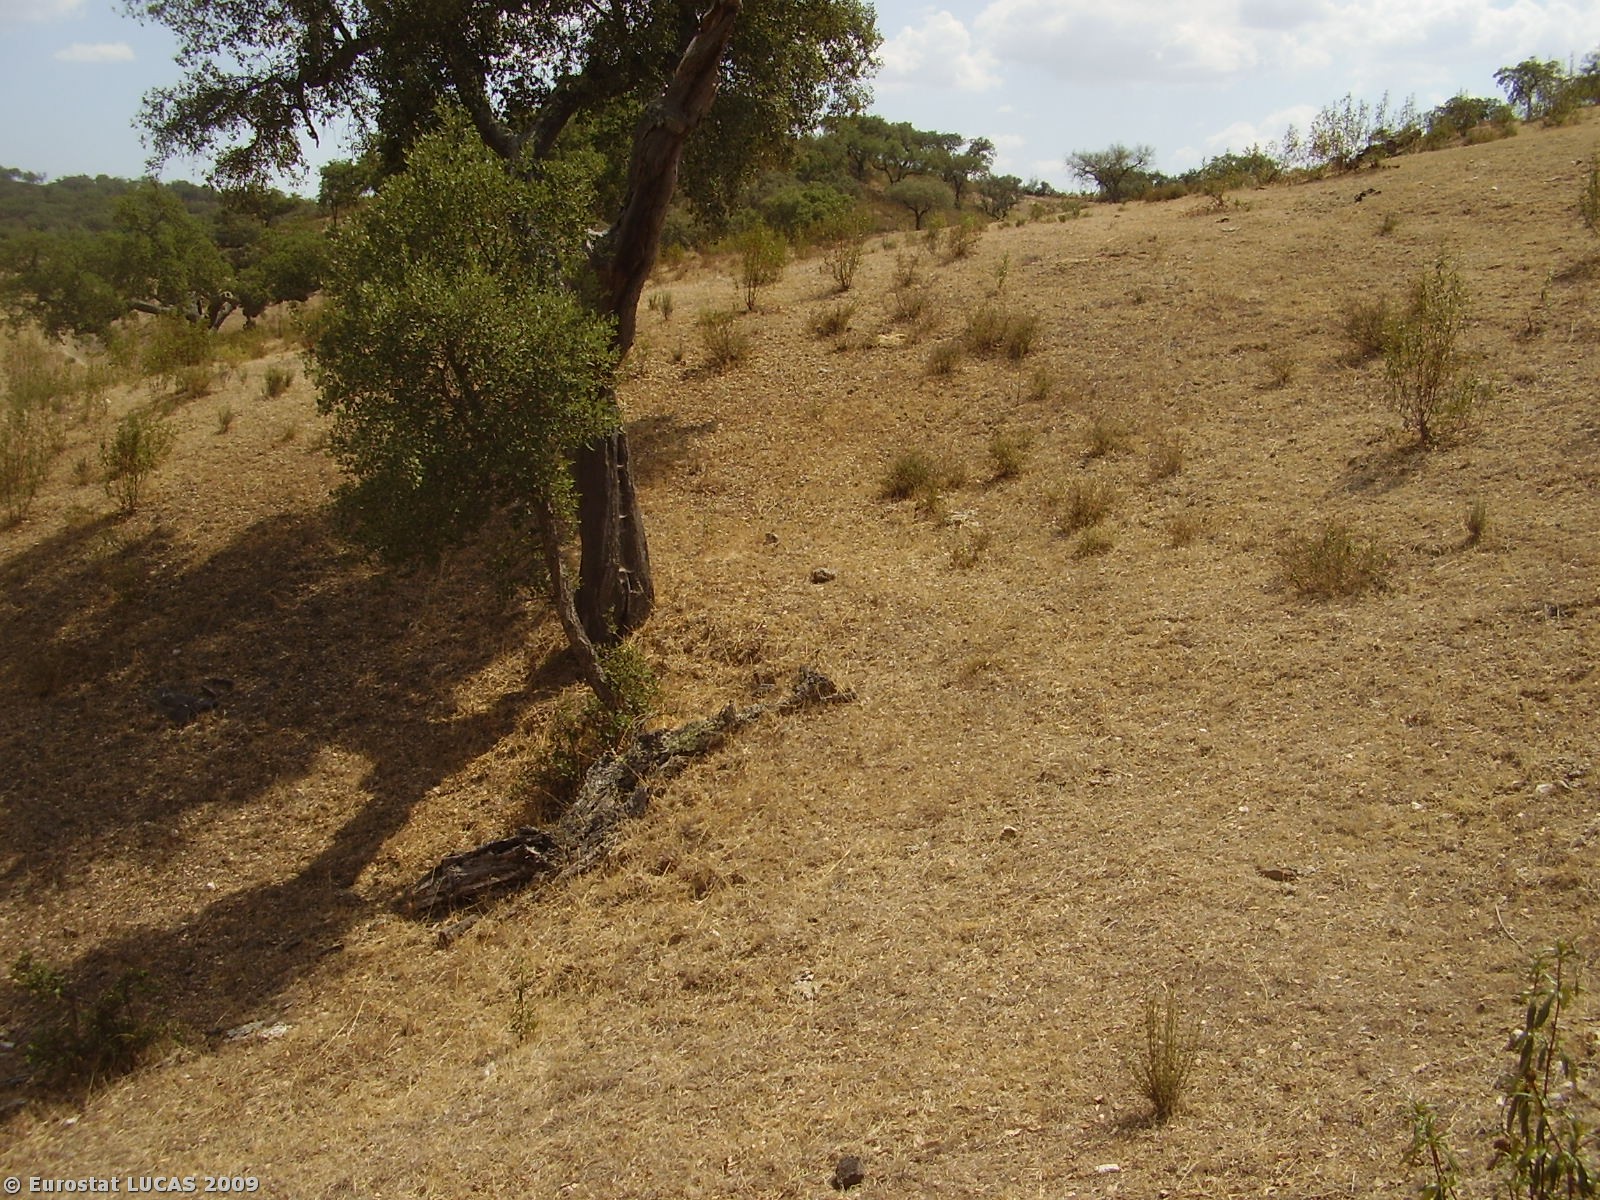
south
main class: Woodland
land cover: Broadleaved woodland
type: broadleaved evergreen forest
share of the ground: 10 - 25 %
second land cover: Bare land
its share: > 75 %
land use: Forestry
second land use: Fallow land
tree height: > 5 m
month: August
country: PT
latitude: 38.2556
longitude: -7.8948
